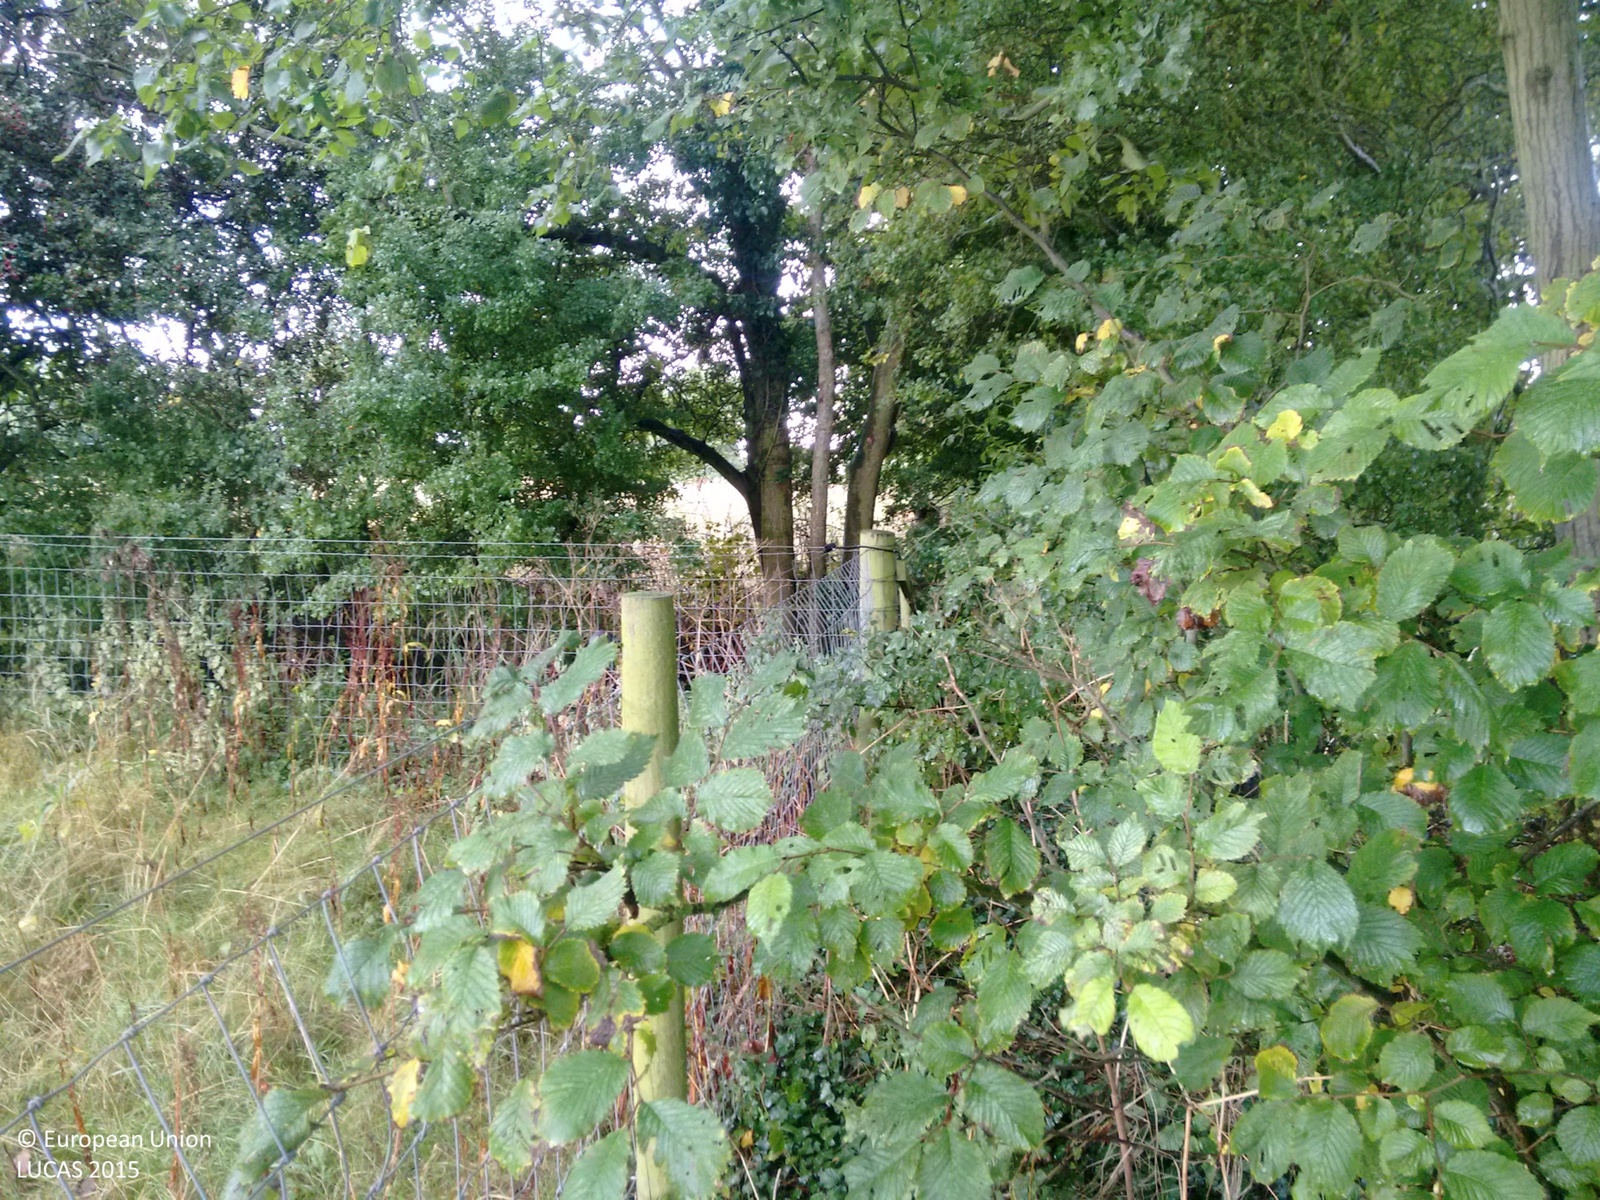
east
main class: Grassland
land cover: Spontaneously vegetated surfaces
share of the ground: > 75 %
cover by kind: herbaceous plants 100 %
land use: Agriculture (excluding fallow land and kitchen gardens)
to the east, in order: Spontaneously vegetated surfaces; Fences; Lines of trees; Ditches and canals; Fences; Grassland without tree/shrub cover; Fences; Lines of trees; Tracks; Fences; Grassland without tree/shrub cover
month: September
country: GB
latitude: 52.2036
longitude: 1.5676
